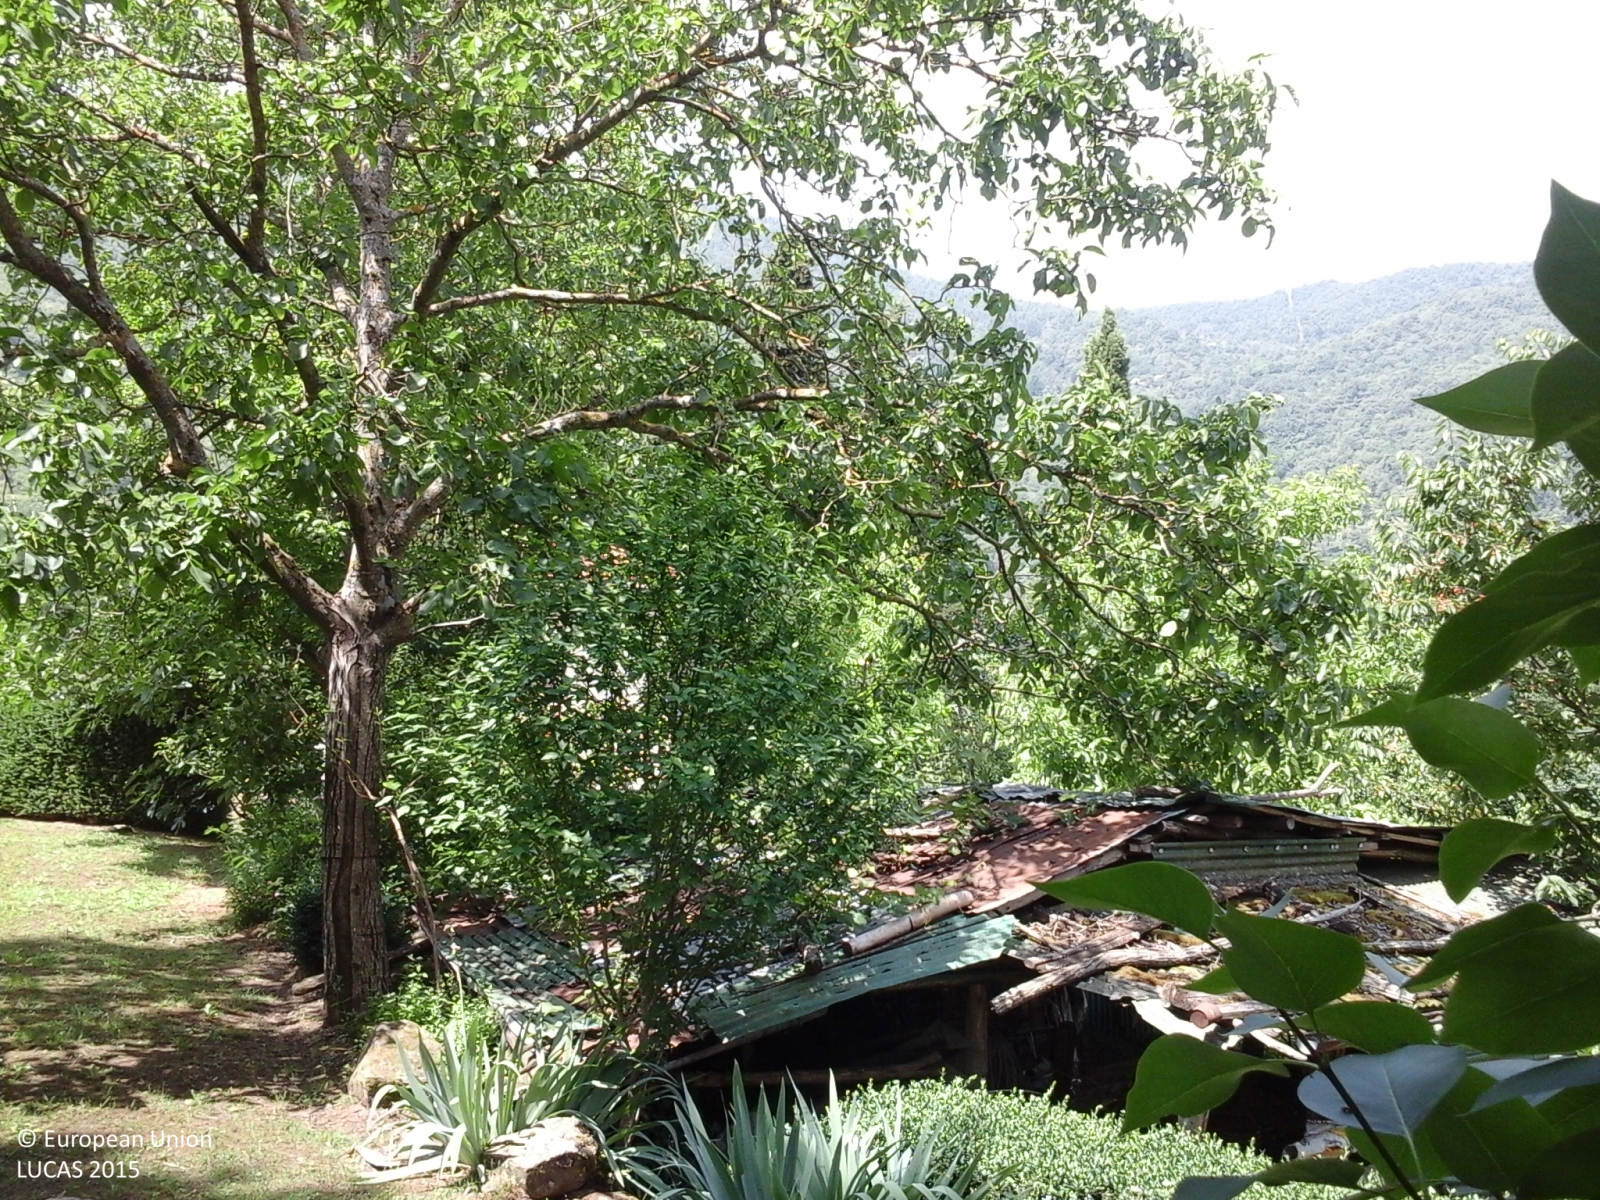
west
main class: Shrubland
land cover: Shrubland with sparse tree cover
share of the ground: > 75 %
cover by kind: shrubs 85 %, herbaceous plants 10 %, broadleaved forest trees 5 %
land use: Semi-natural and natural areas not in use
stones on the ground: < 10 %
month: June
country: IT
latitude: 43.8334
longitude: 11.5754
